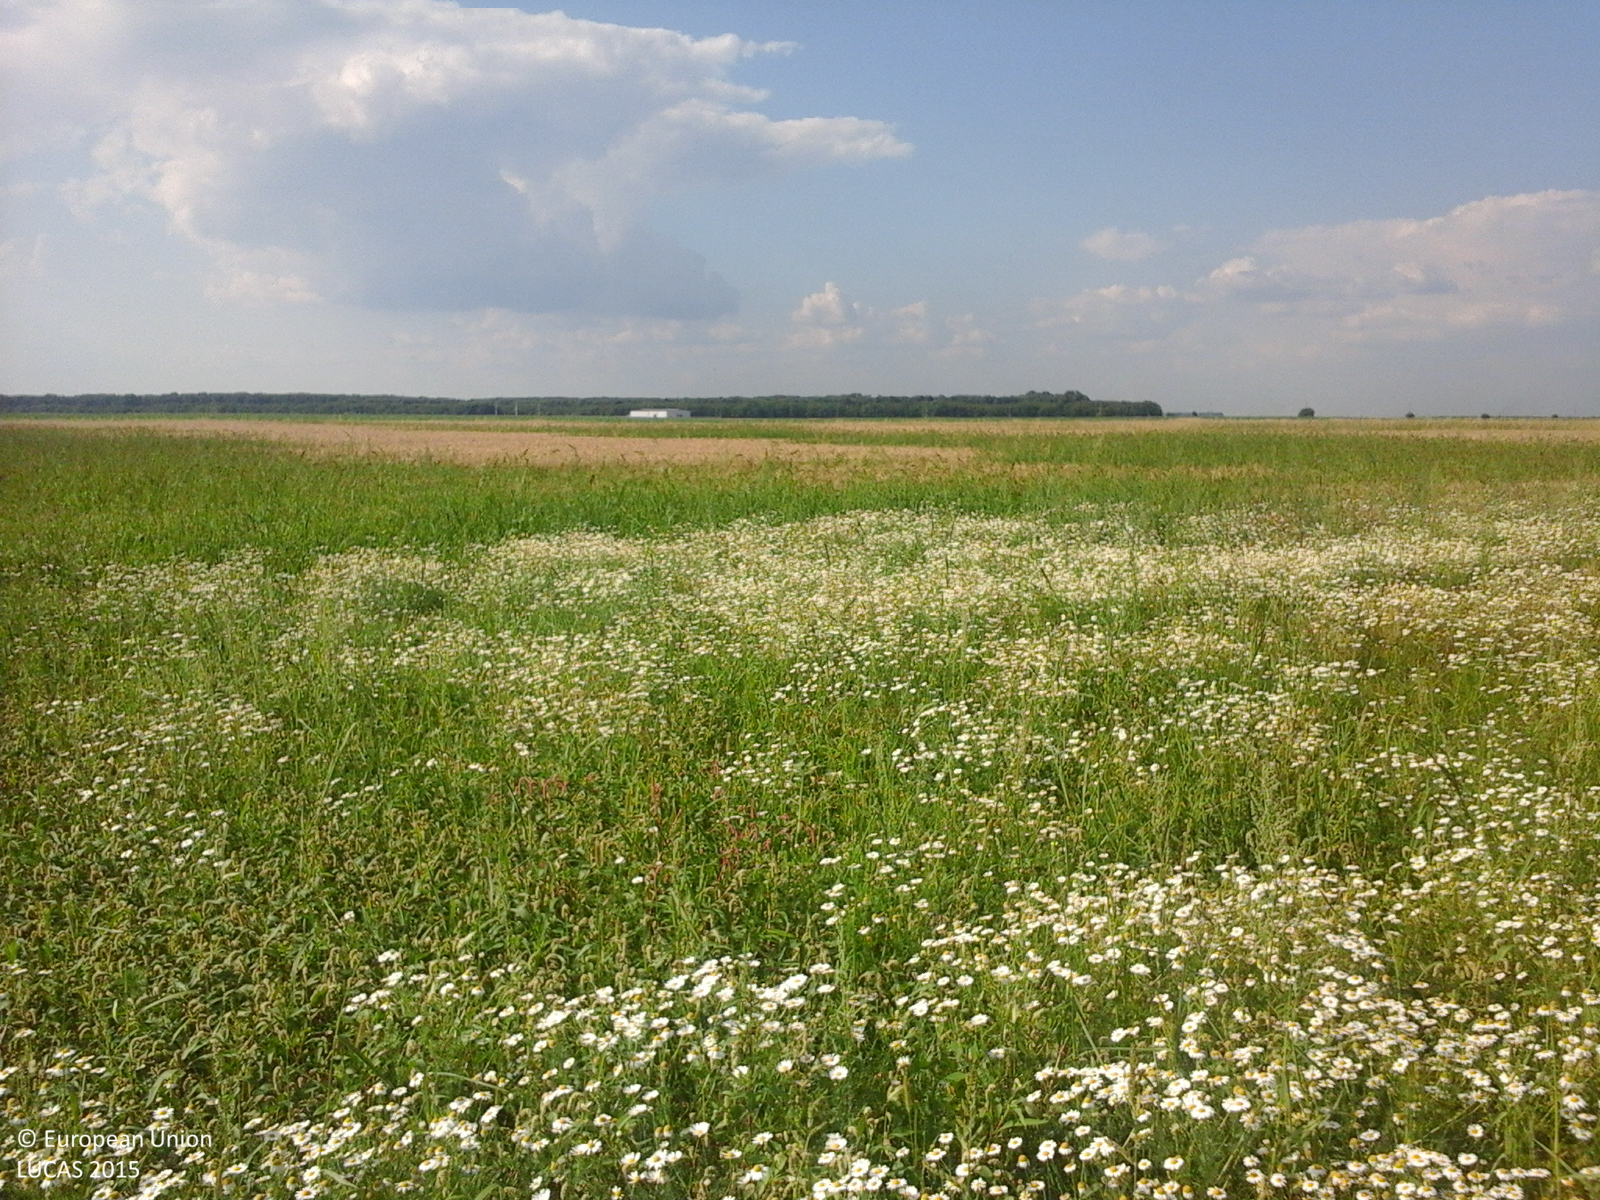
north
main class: Grassland
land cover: Grassland without tree/shrub cover
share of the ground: > 75 %
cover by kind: herbaceous plants 100 %
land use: Agriculture (excluding fallow land and kitchen gardens)
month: July
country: RO
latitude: 44.0649
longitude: 25.8124
